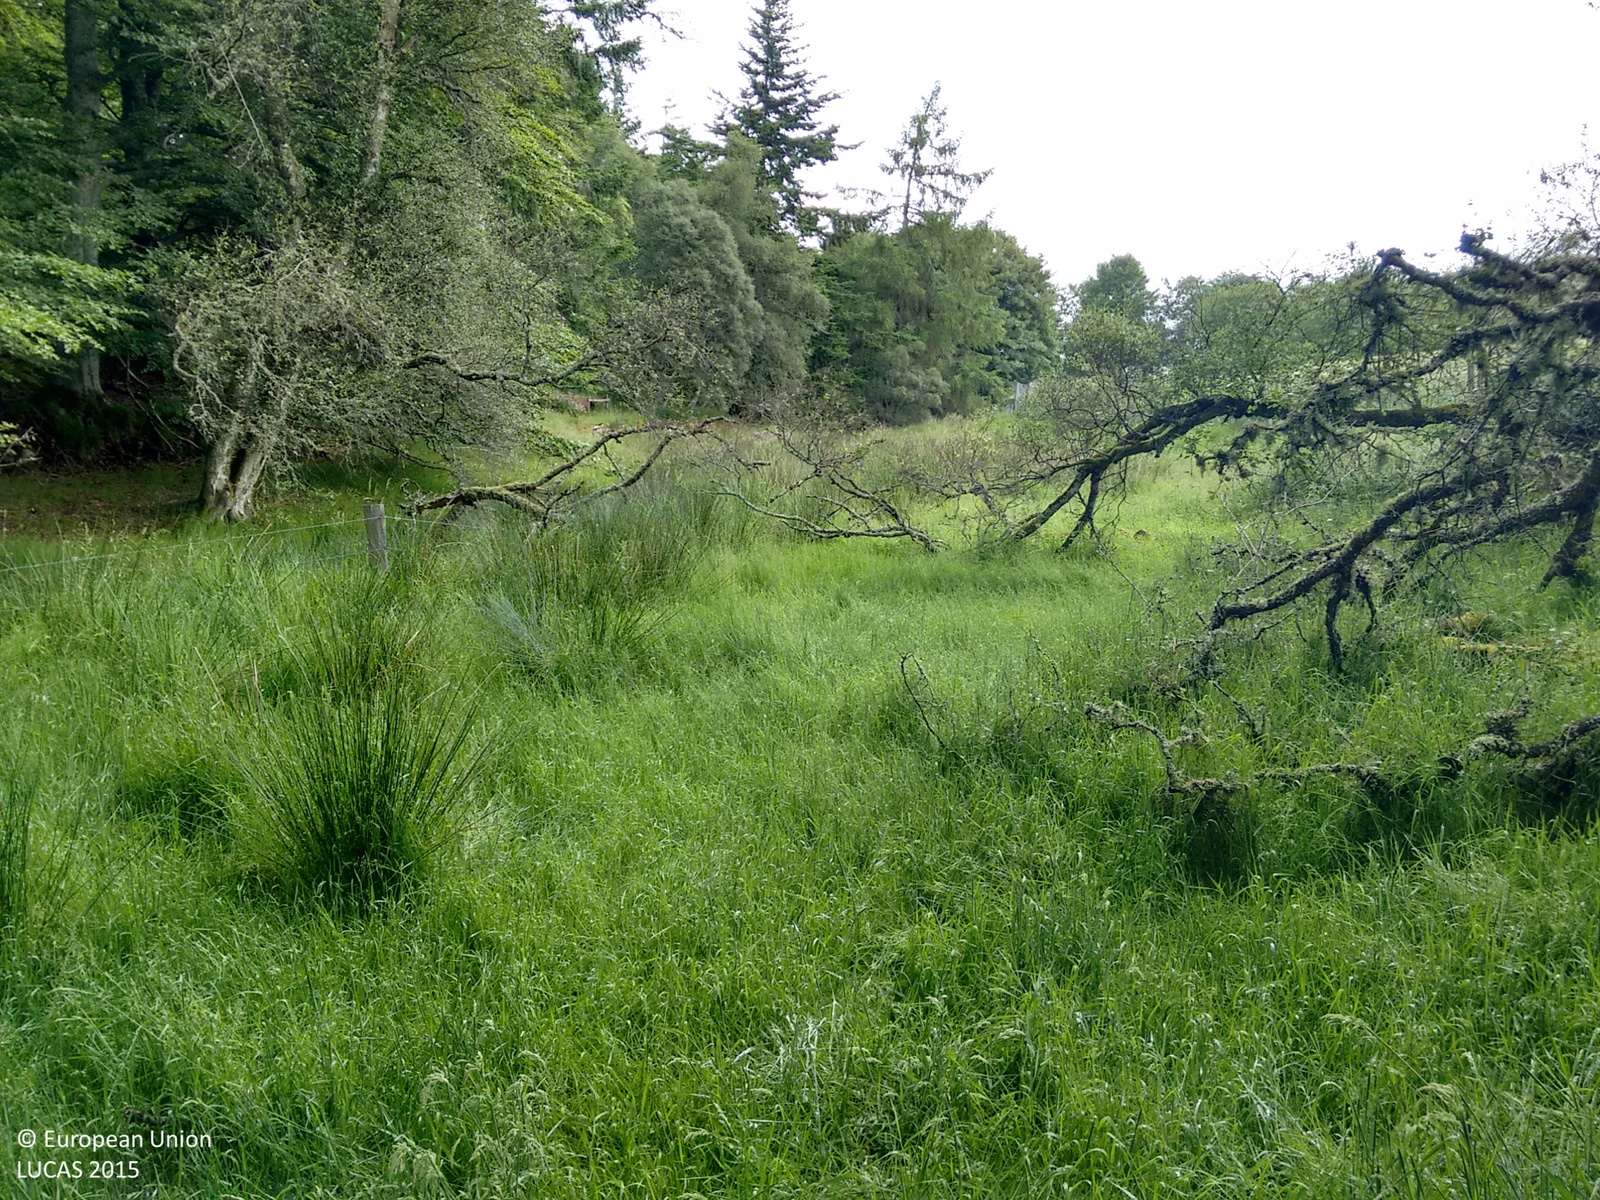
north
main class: Woodland
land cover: Broadleaved woodland
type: mesophytic deciduous forest
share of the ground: > 75 %
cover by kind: broadleaved forest trees 80 %, herbaceous plants 20 %
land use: Semi-natural and natural areas not in use
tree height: > 5 m
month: July
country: GB
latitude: 57.2296
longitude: -2.8985
